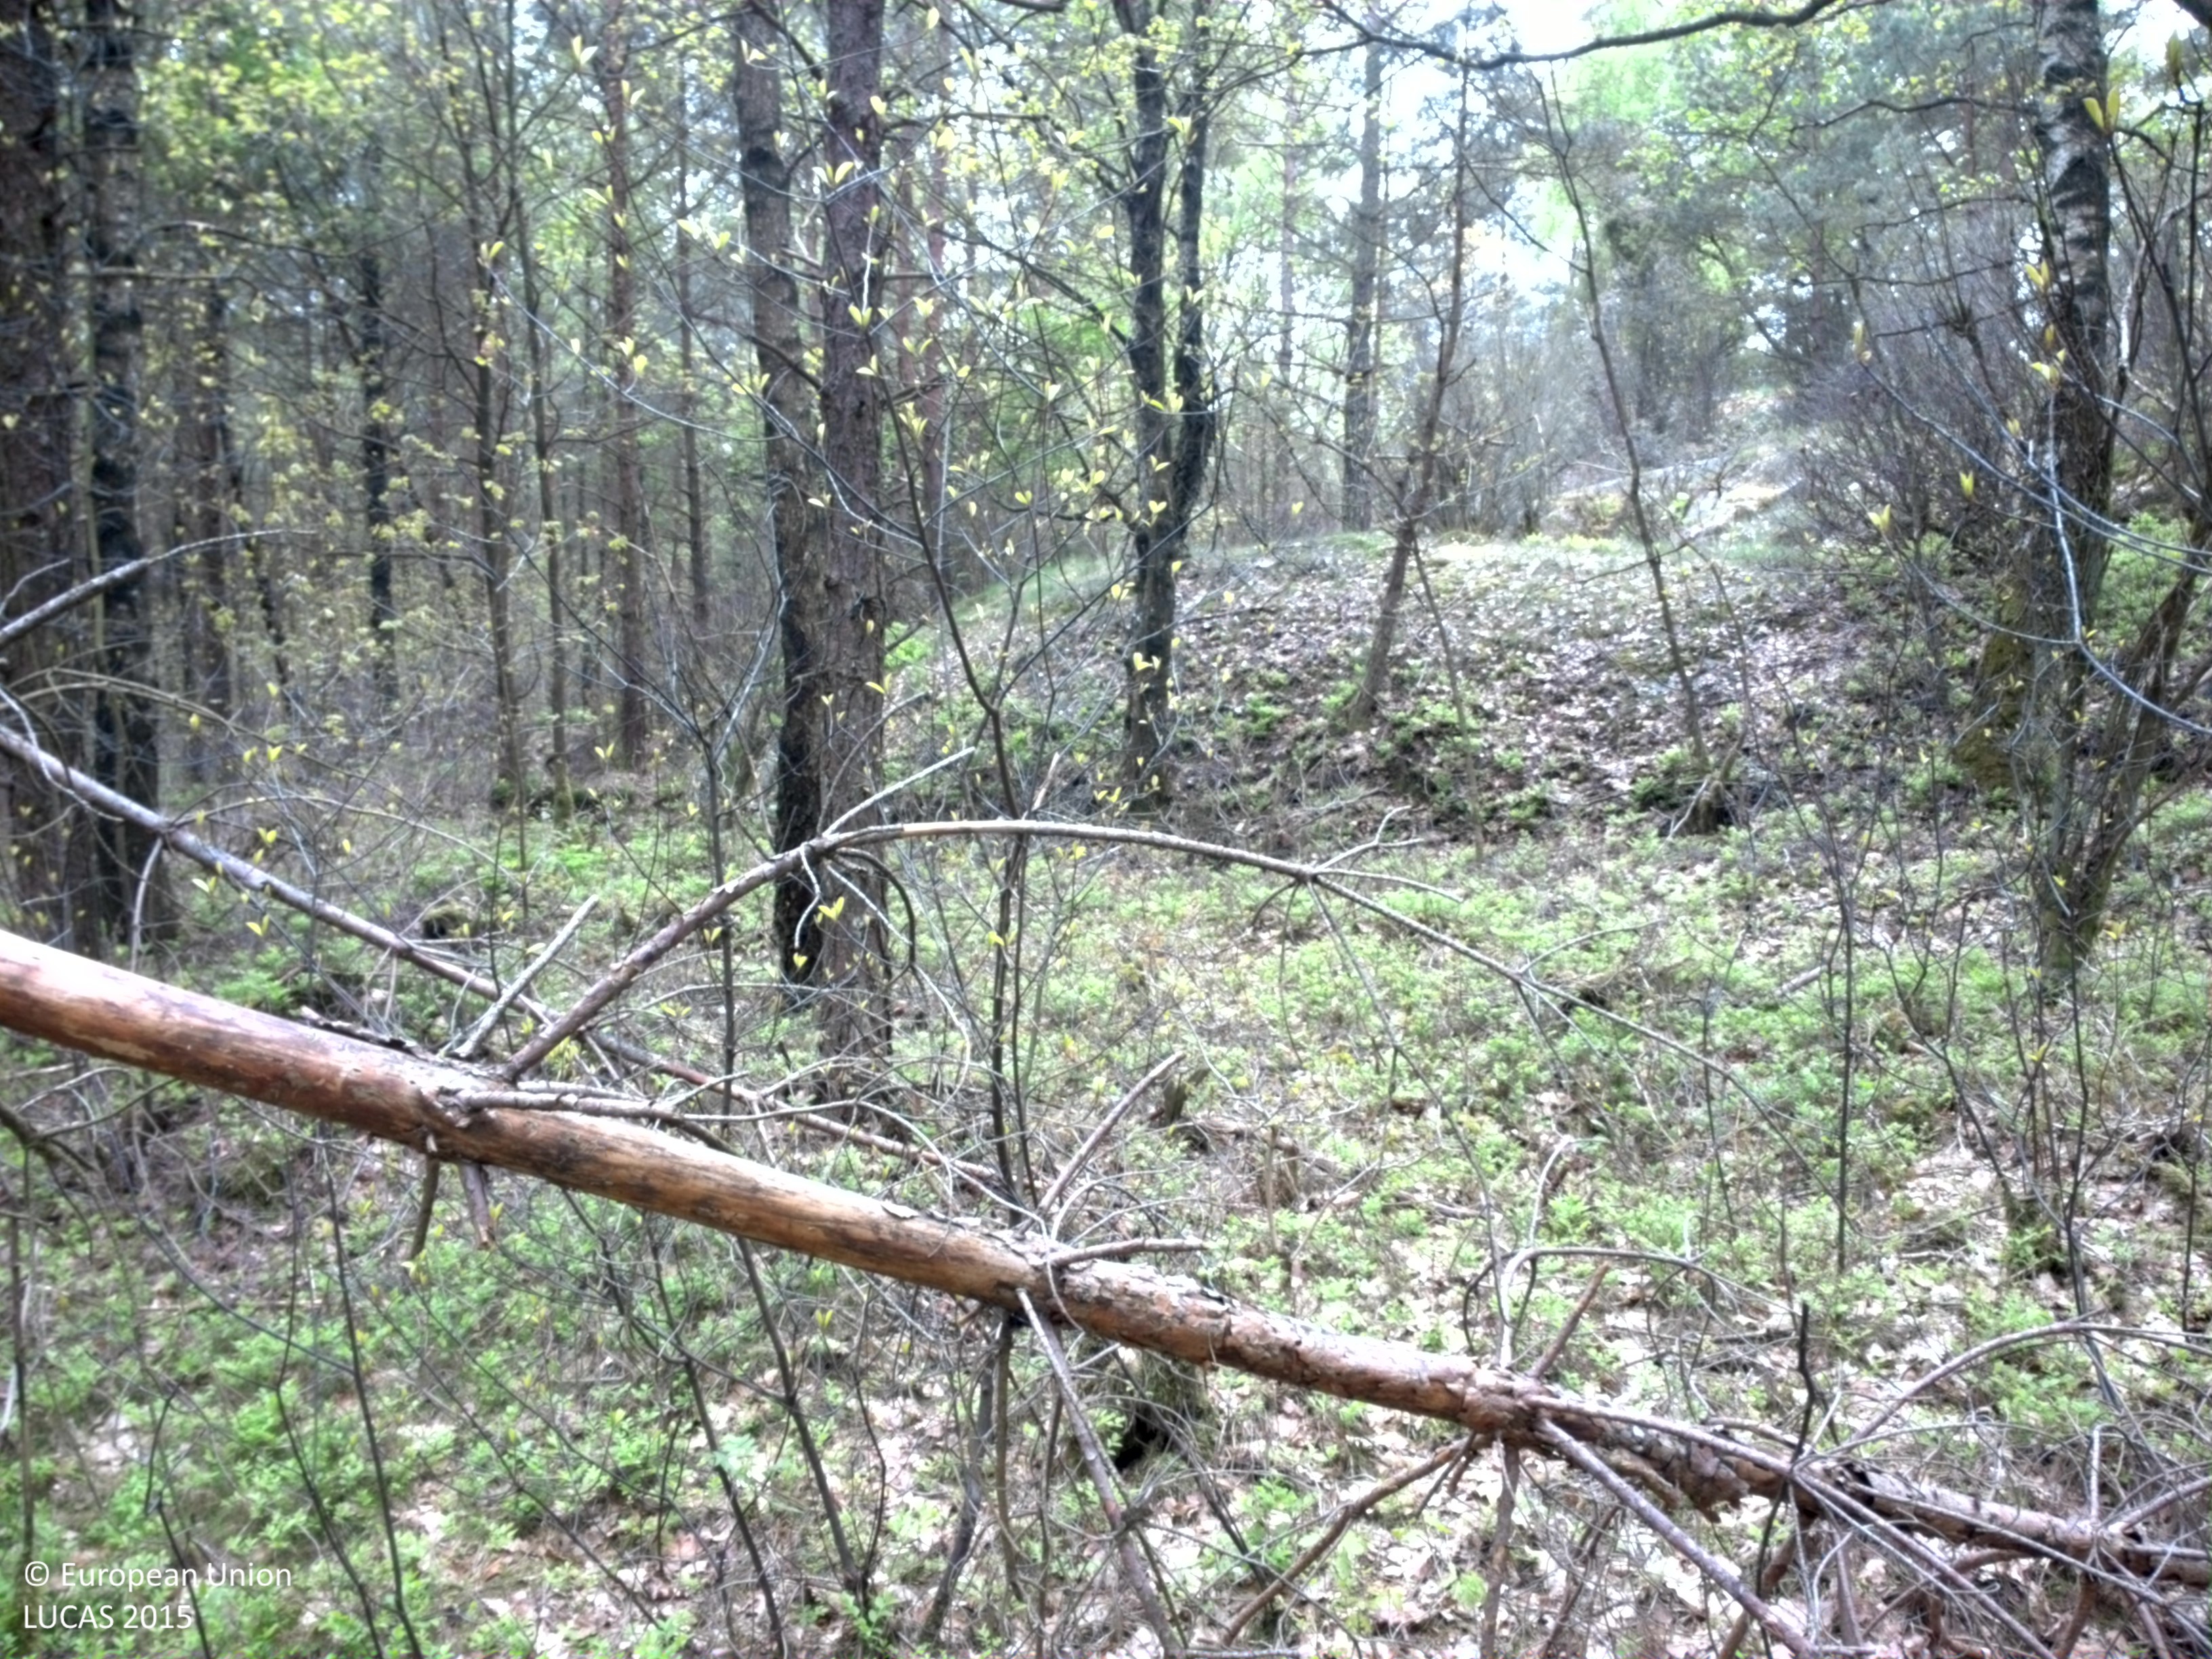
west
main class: Woodland
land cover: Pine dominated mixed woodland
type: boreal forest
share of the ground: > 75 %
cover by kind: coniferous forest trees 55 %, broadleaved forest trees 25 %, shrubs 15 %, herbaceous plants 5 %
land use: Forestry
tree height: > 5 m
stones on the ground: < 10 %
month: May
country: SE
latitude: 57.8093
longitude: 11.9657
